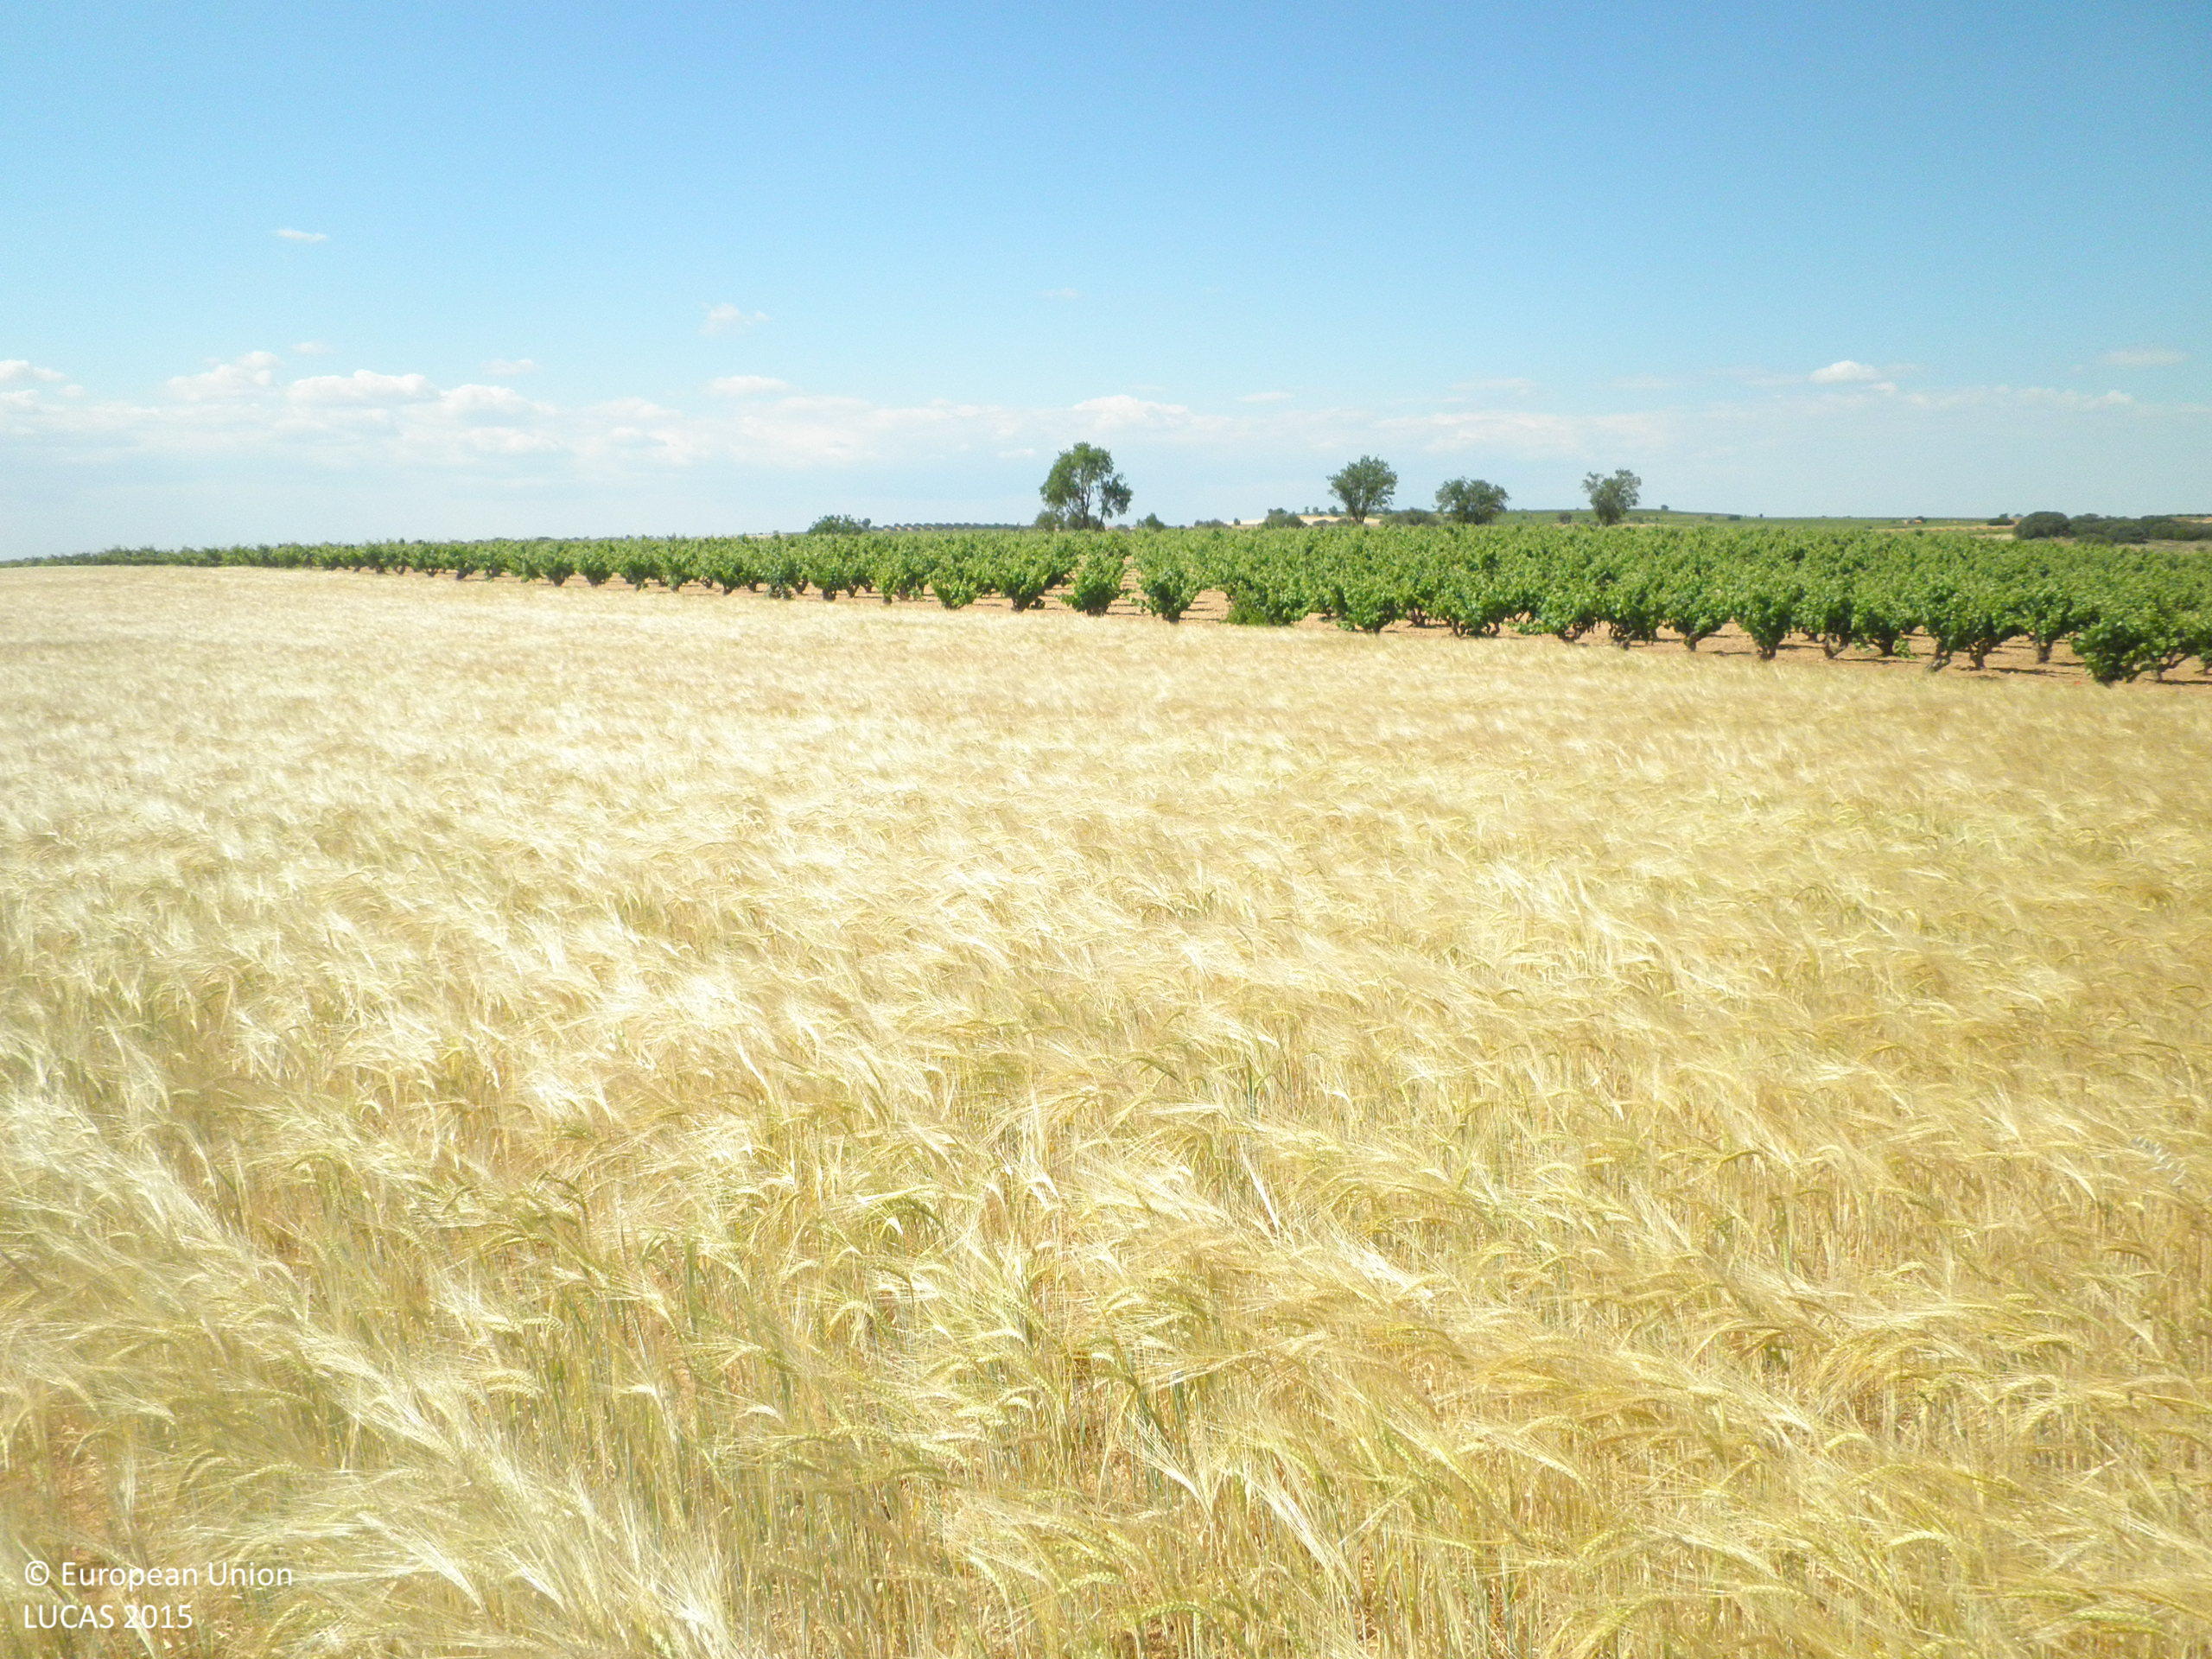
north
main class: Cropland
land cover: Barley
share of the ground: > 75 %
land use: Agriculture (excluding fallow land and kitchen gardens)
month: June
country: ES
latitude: 39.4073
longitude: -1.7928
